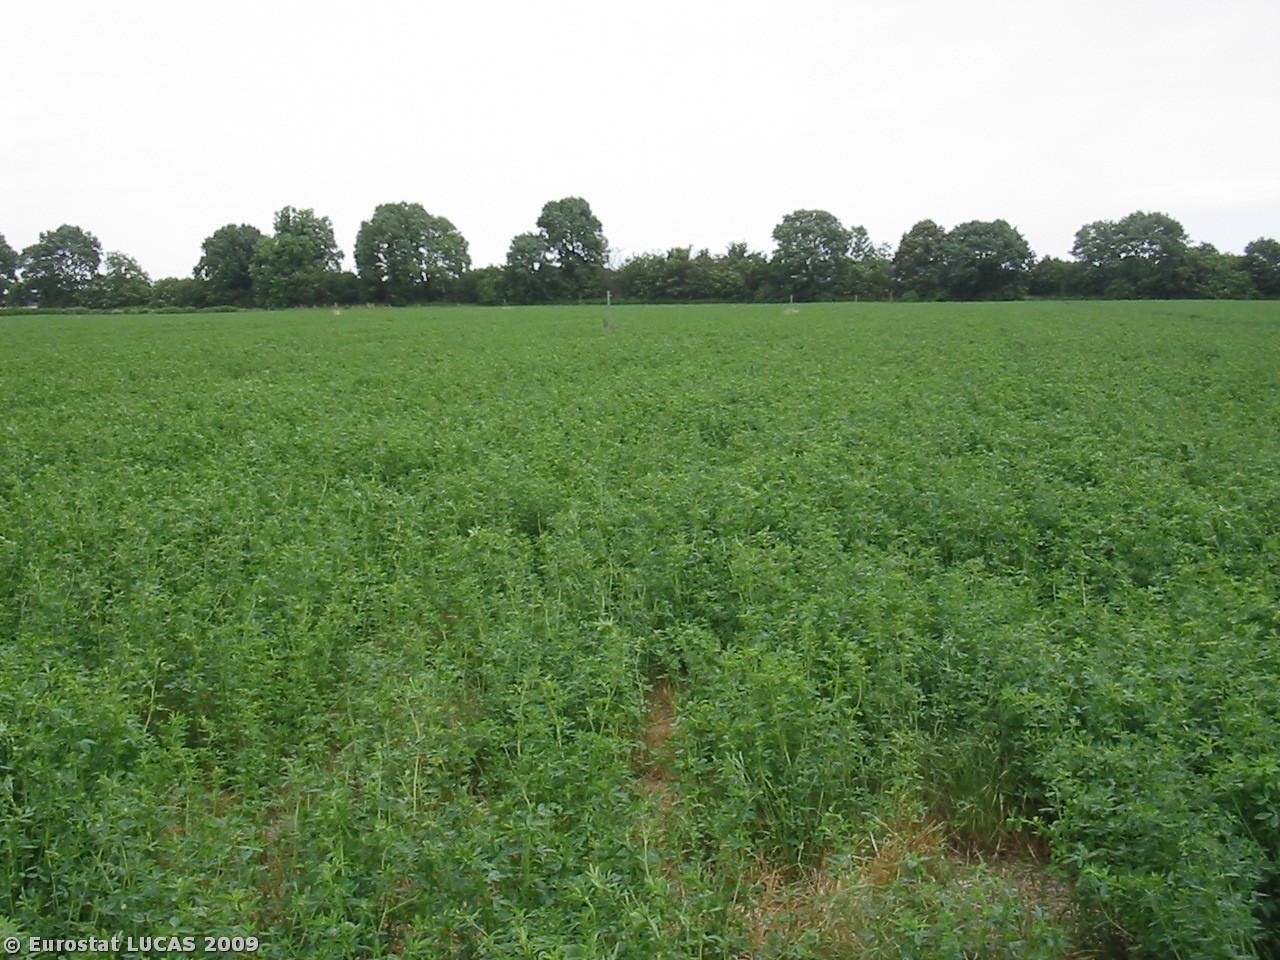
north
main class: Cropland
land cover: Lucerne
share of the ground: > 75 %
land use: Agriculture (excluding fallow land and kitchen gardens)
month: June
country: IT
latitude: 42.9512
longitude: 12.3830
